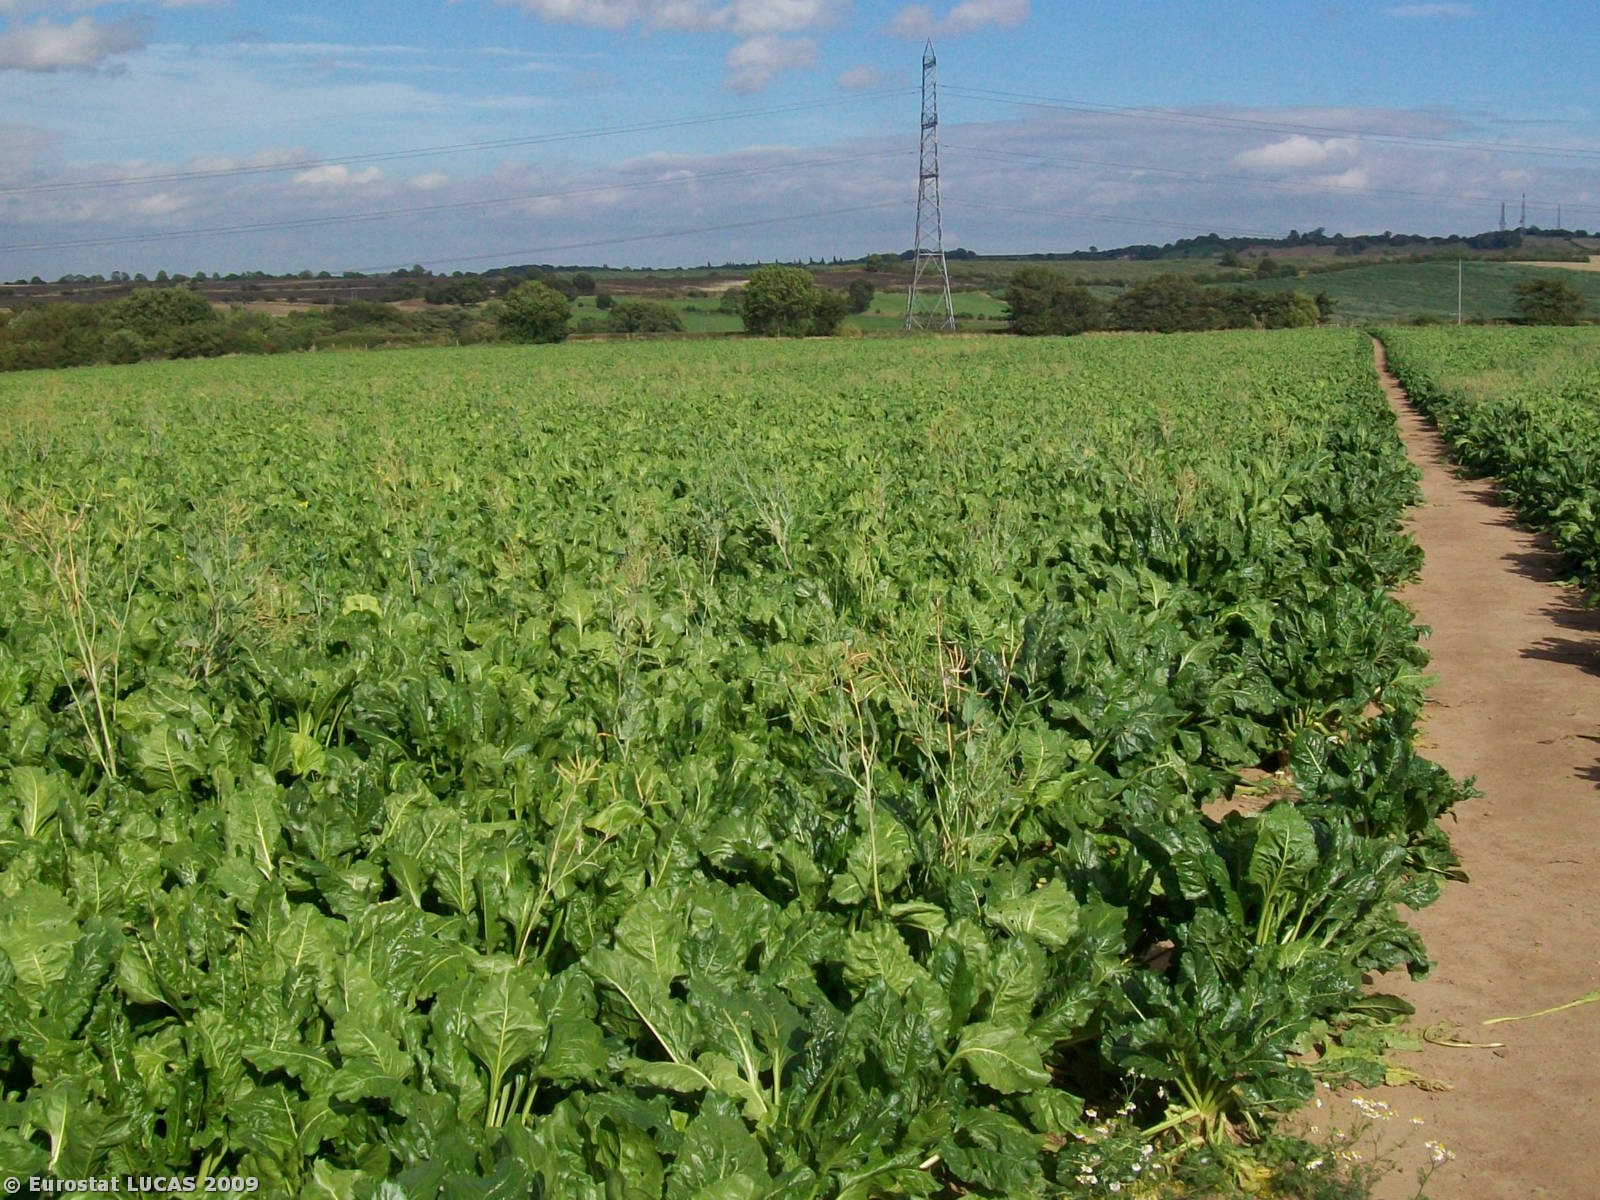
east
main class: Cropland
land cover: Other root crops
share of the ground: > 75 %
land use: Agriculture (excluding fallow land and kitchen gardens)
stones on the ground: 10 - 25 %
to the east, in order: Other root crops; Grass margins
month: September
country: GB
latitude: 53.4554
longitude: -1.2664
